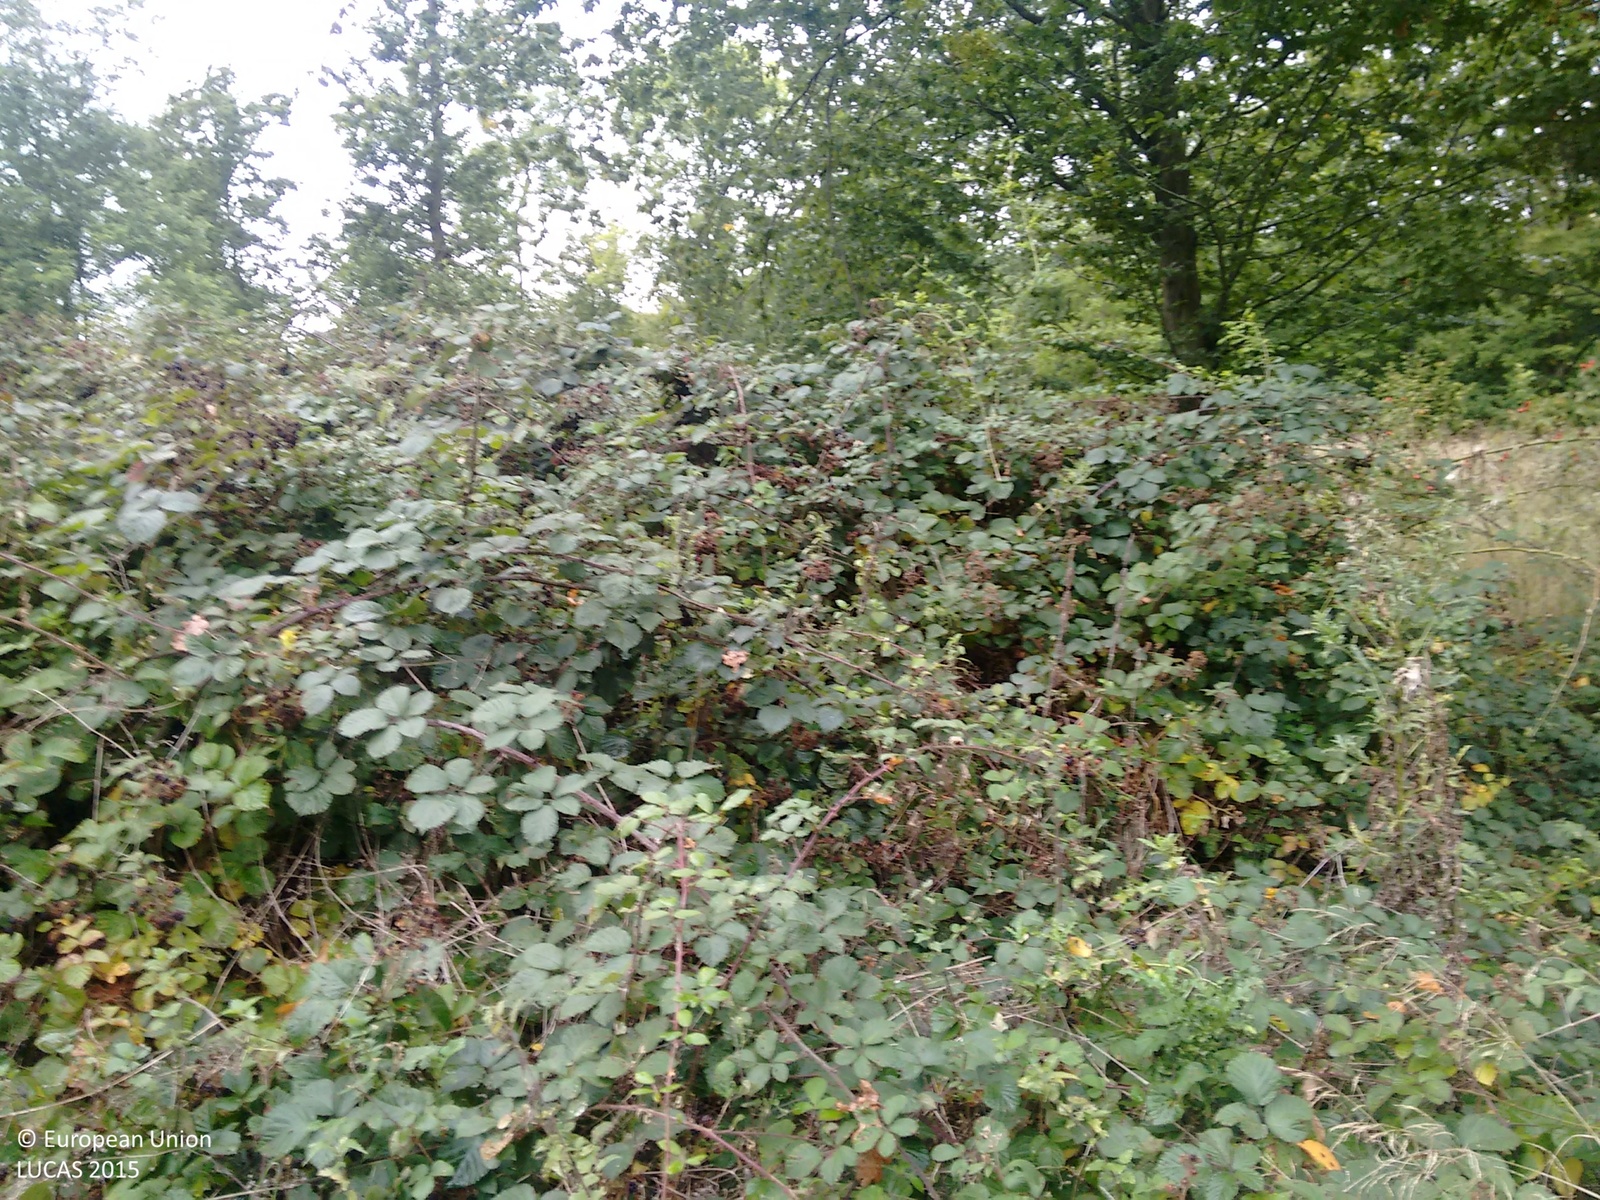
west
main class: Woodland
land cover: Broadleaved woodland
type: mesophytic deciduous forest
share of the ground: 25 - 50 %
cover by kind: shrubs 50 %, broadleaved forest trees 40 %, herbaceous plants 10 %
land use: Forestry
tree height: > 5 m
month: September
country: GB
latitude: 51.9784
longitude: 0.2886
